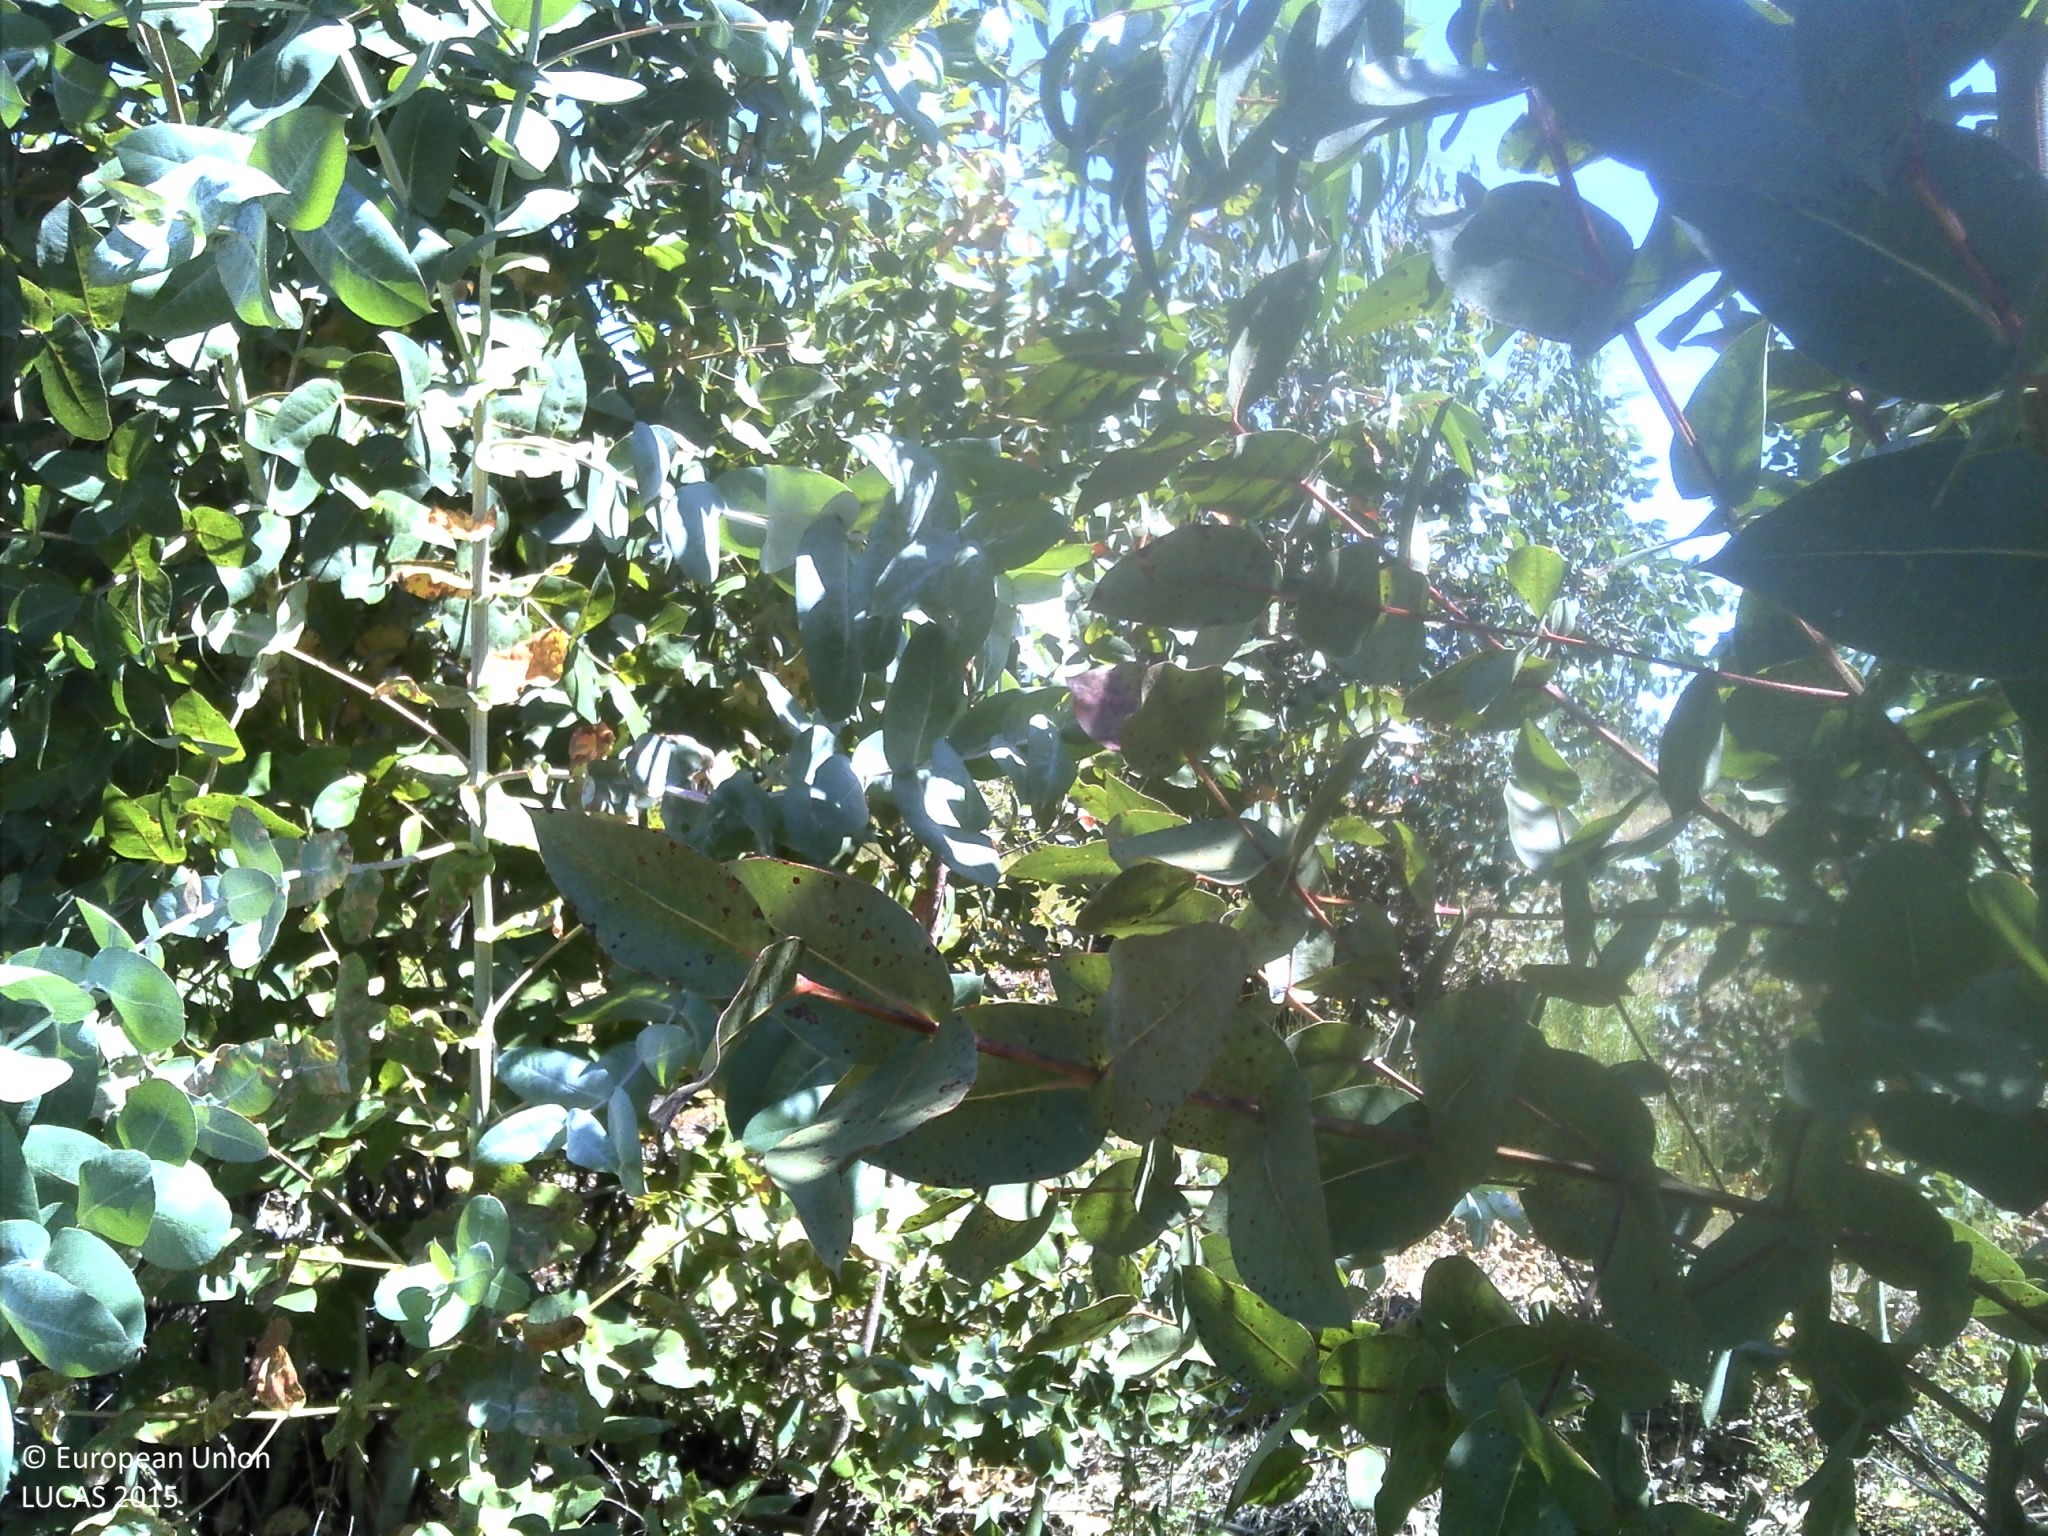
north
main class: Woodland
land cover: Broadleaved woodland
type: exotic forest
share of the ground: 50 - 75 %
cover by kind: broadleaved forest trees 70 %, herbaceous plants 15 %, unconsolidated bare surface 15 %
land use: Forestry
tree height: > 5 m
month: May
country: PT
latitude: 39.4323
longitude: -8.3177
